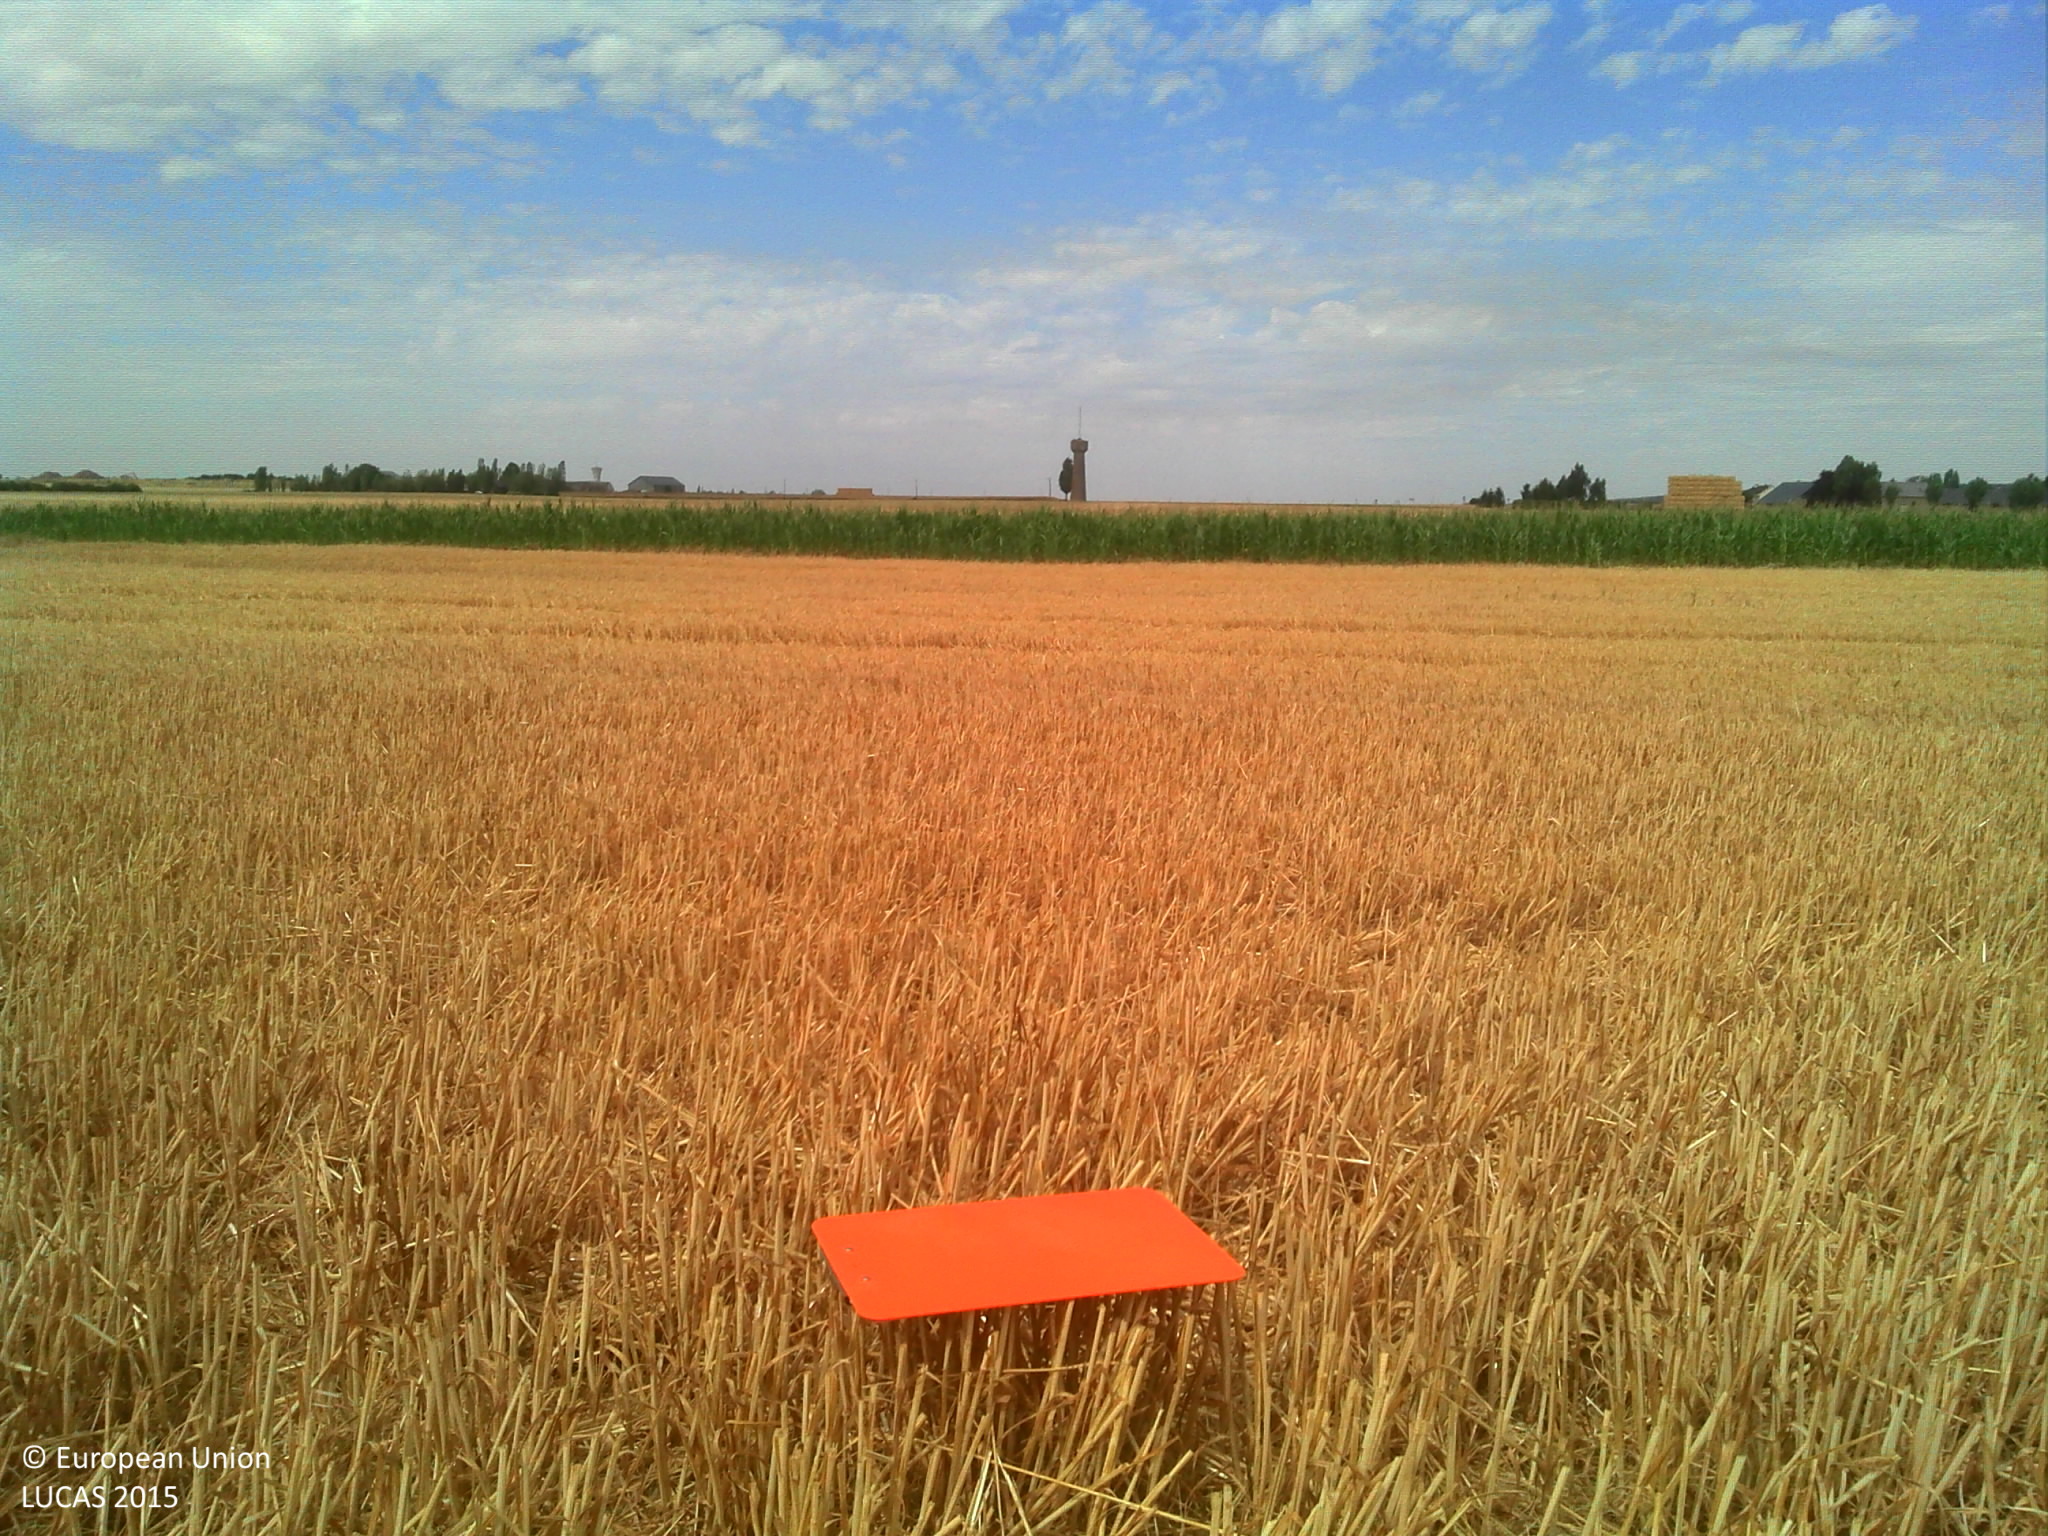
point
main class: Cropland
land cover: Common wheat
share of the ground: > 75 %
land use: Agriculture (excluding fallow land and kitchen gardens)
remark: Harvested field
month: July
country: FR
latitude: 48.4498
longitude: 1.4244
